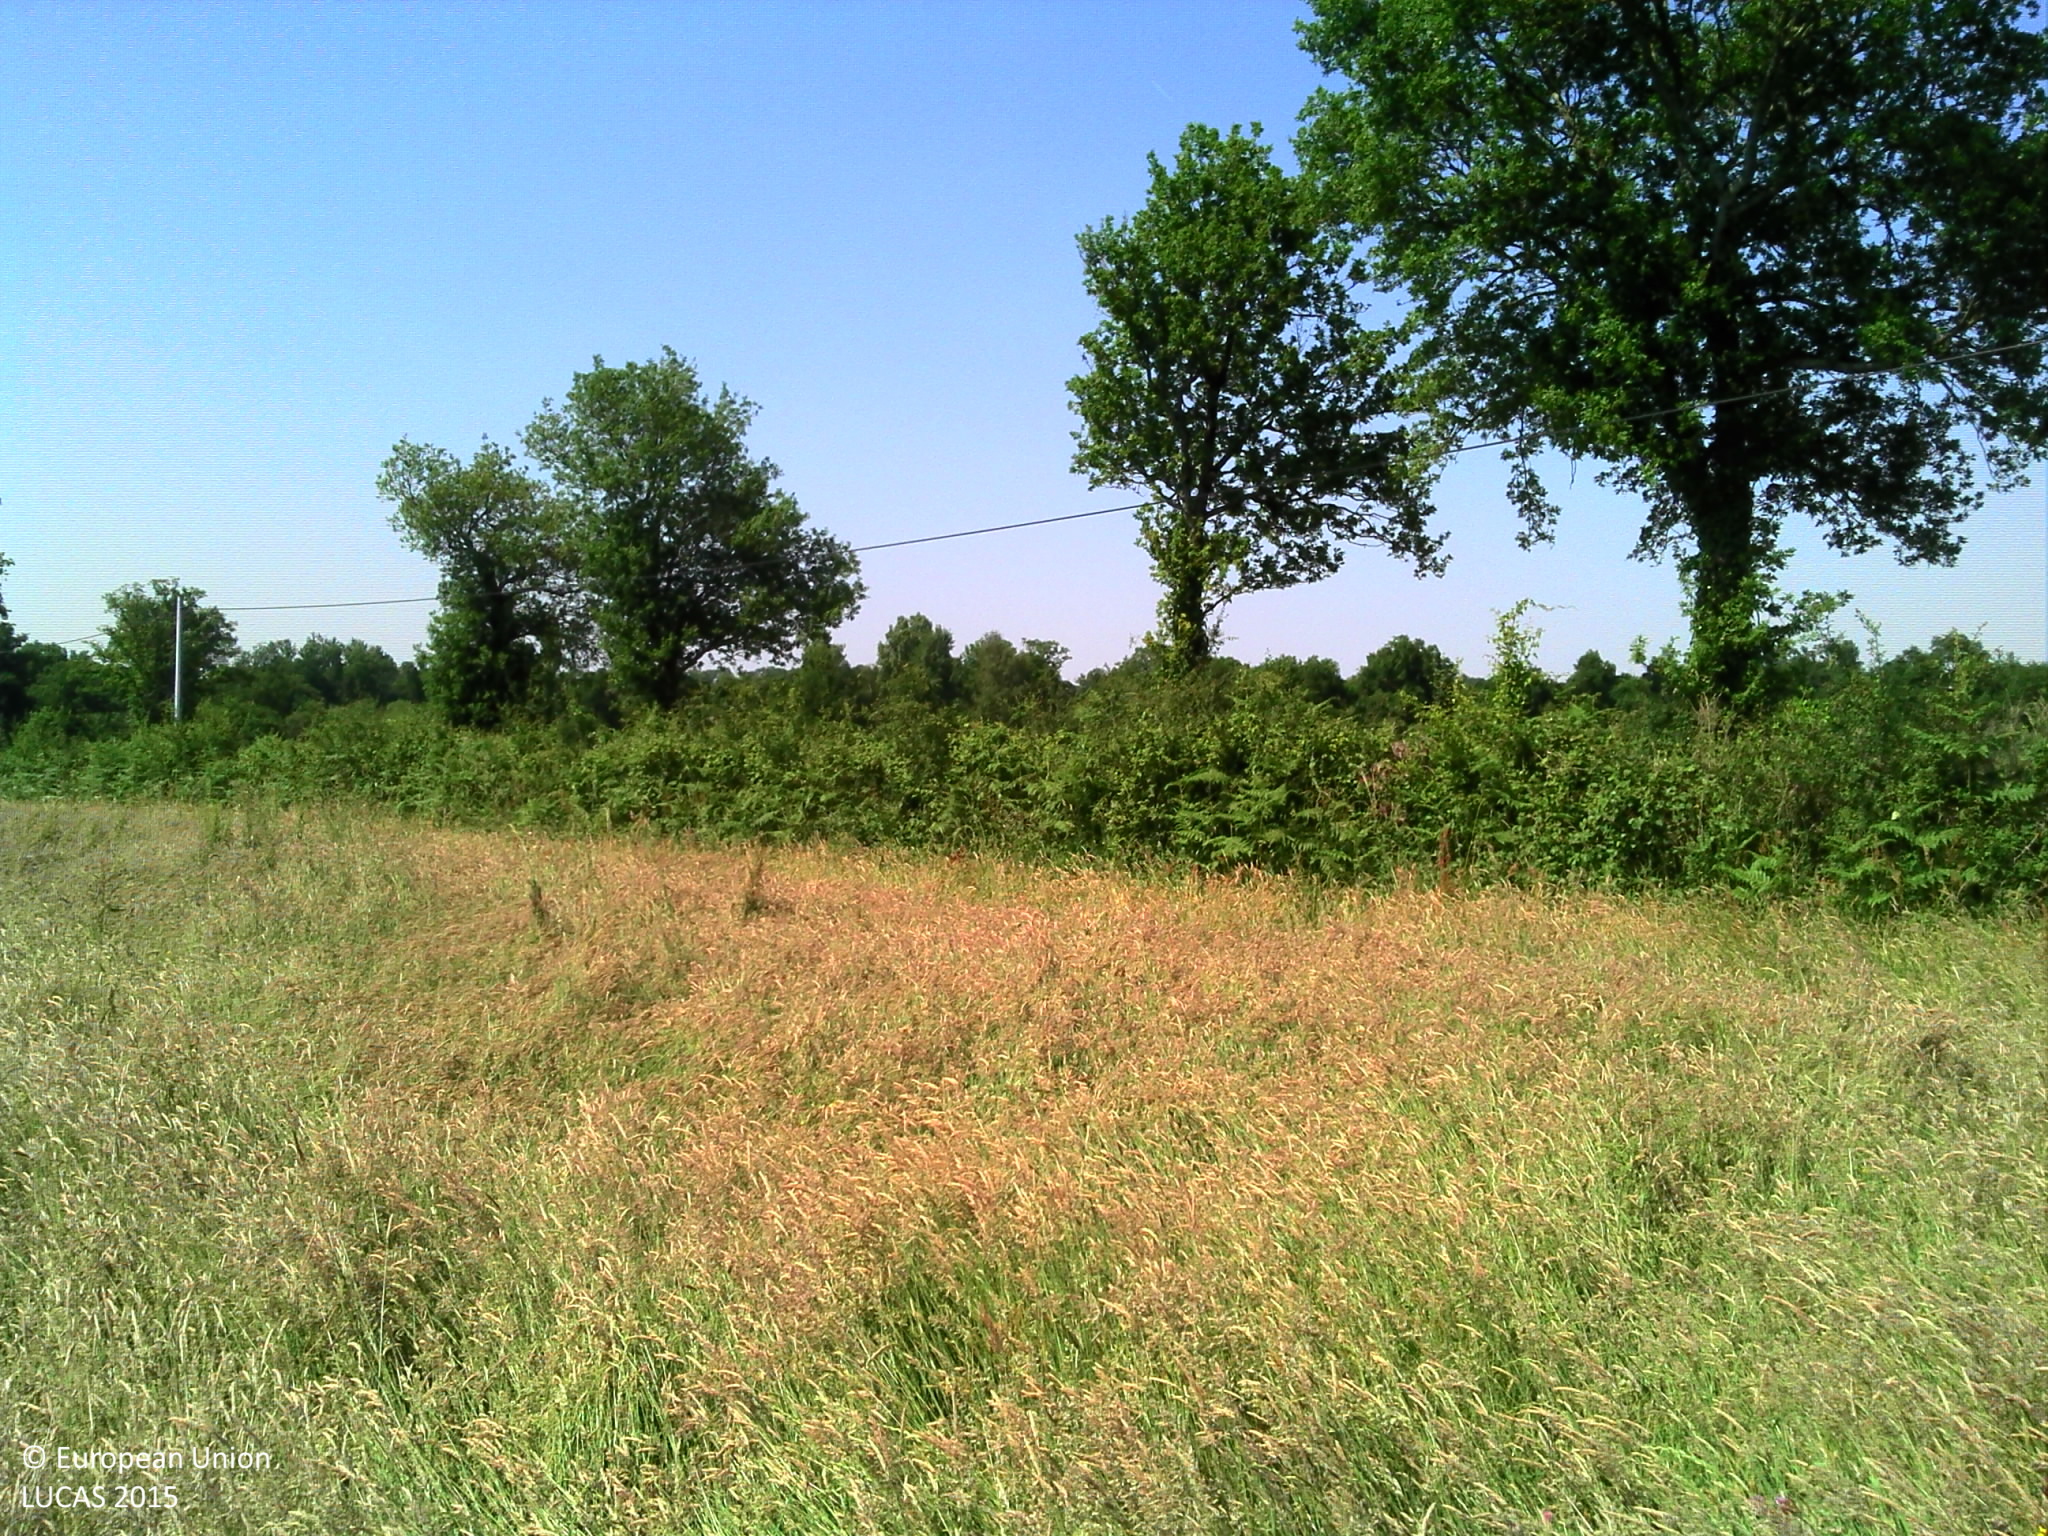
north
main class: Grassland
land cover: Grassland without tree/shrub cover
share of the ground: > 75 %
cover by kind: herbaceous plants 100 %
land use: Agriculture (excluding fallow land and kitchen gardens)
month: June
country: FR
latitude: 46.0622
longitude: 0.5873
